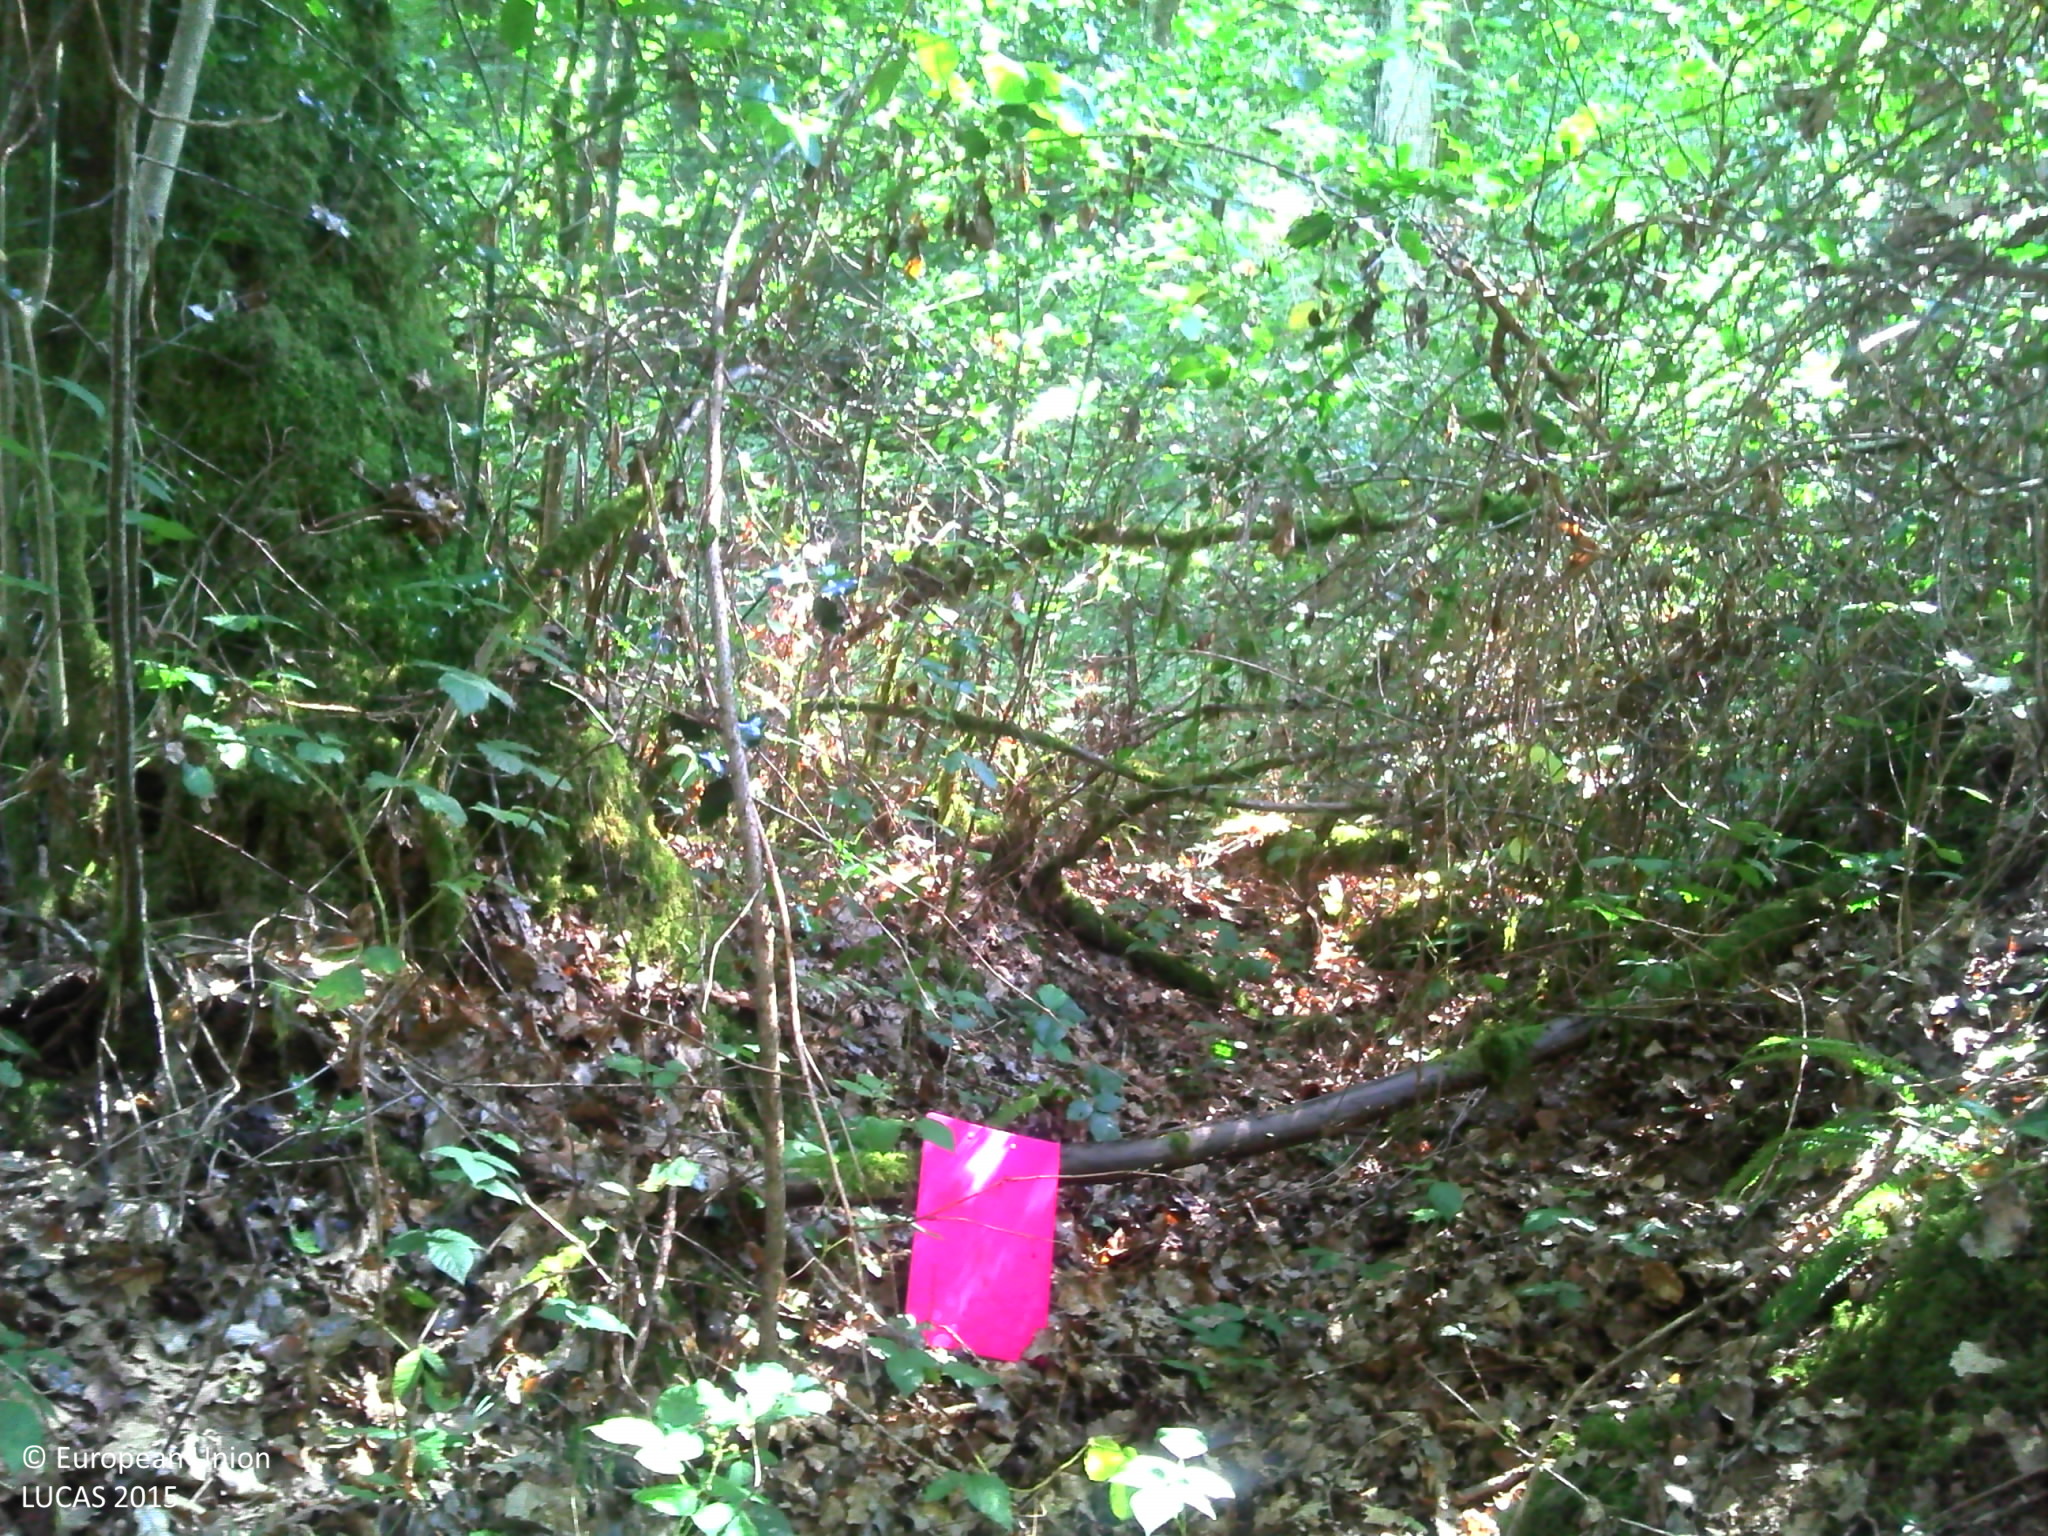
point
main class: Woodland
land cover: Spruce dominated mixed woodland
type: mesophytic deciduous forest
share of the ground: > 75 %
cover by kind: broadleaved forest trees 40 %, coniferous forest trees 25 %, shrubs 25 %, herbaceous plants 5 %, lichens and mosses 5 %
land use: Forestry
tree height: > 5 m
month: August
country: FR
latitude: 45.9734
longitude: 1.6941
